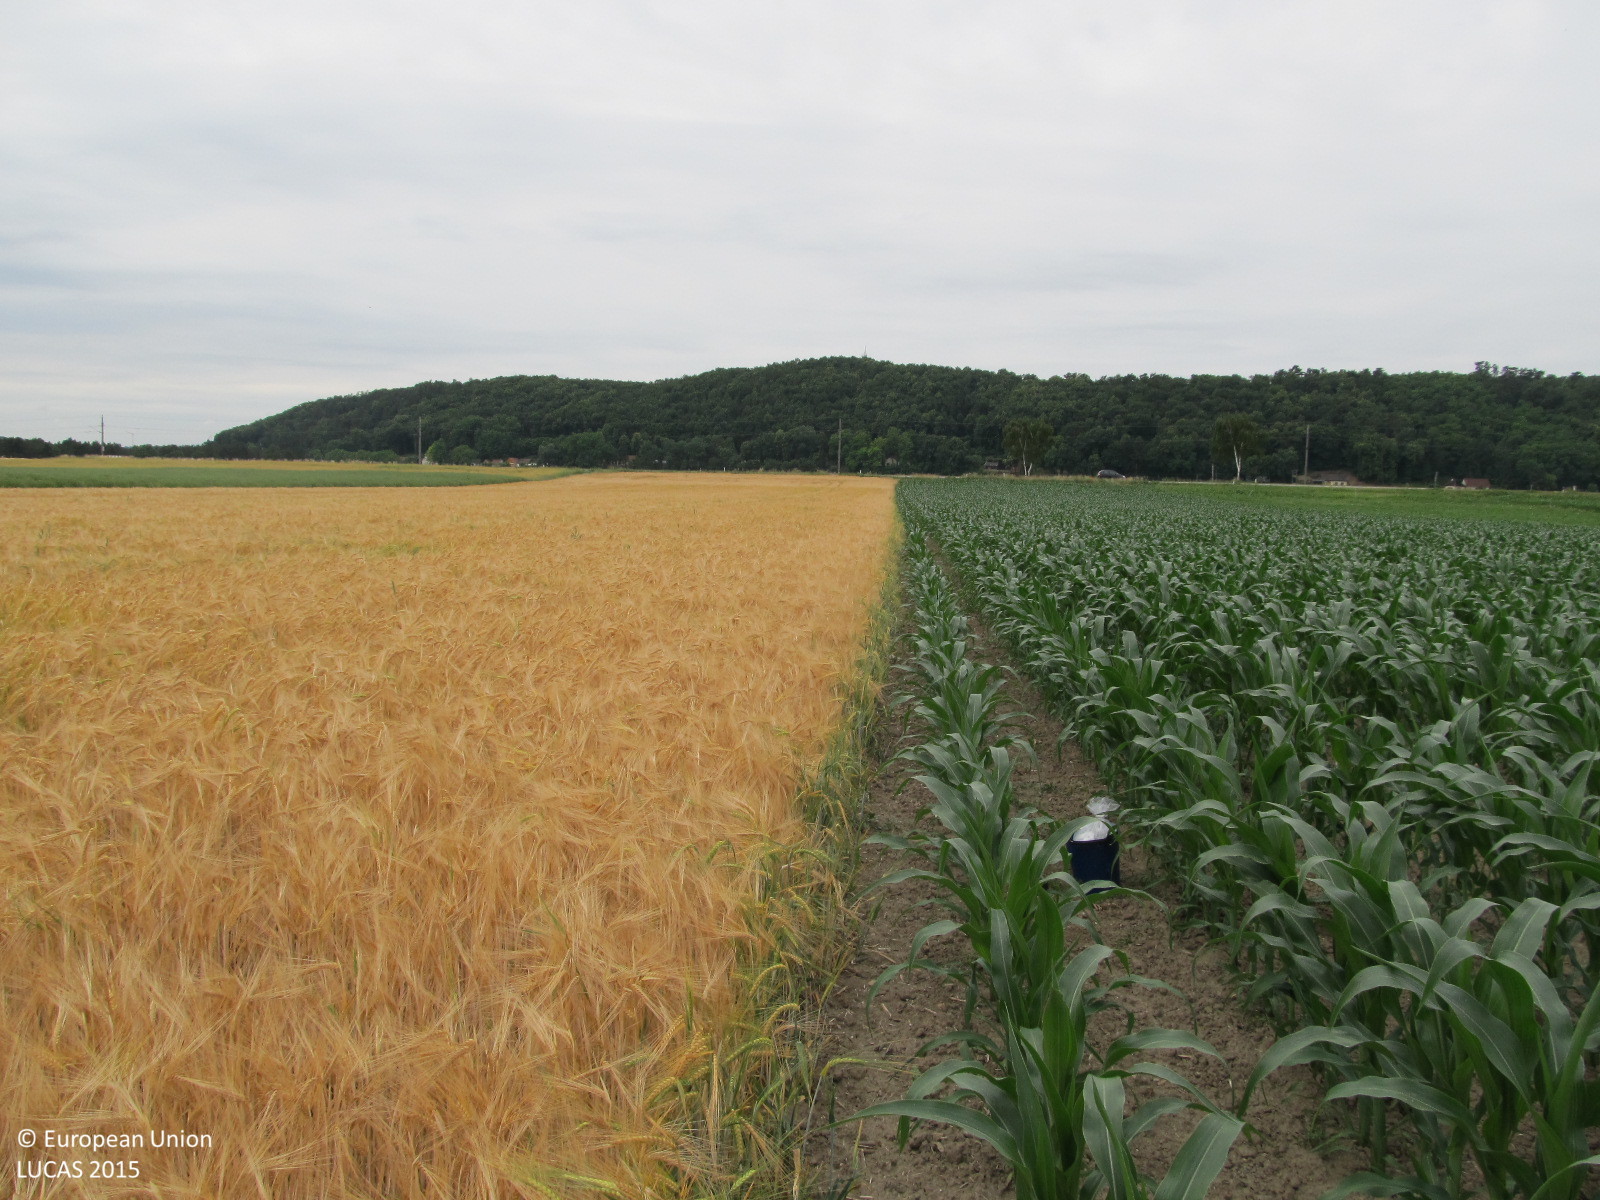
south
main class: Cropland
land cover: Barley
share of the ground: > 75 %
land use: Agriculture (excluding fallow land and kitchen gardens)
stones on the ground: < 10 %
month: June
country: AT
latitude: 48.3419
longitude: 15.7913
